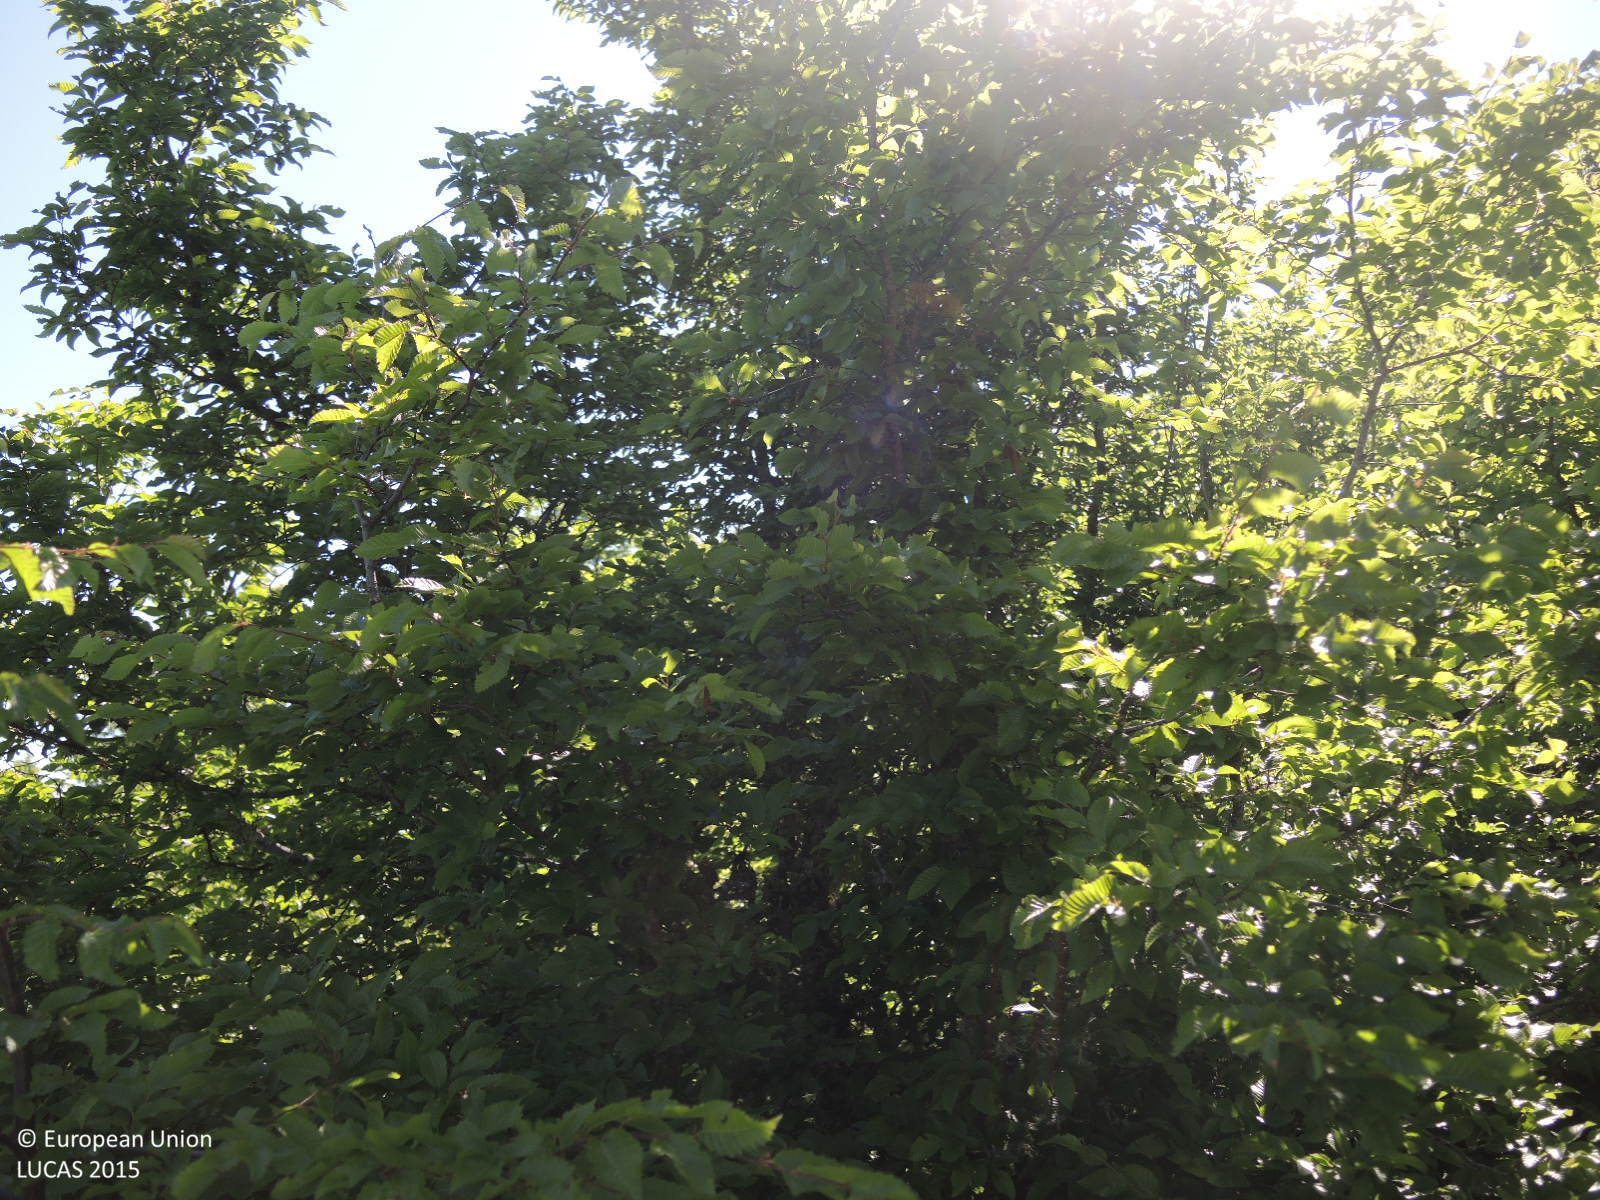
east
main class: Woodland
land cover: Broadleaved woodland
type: mesophytic deciduous forest
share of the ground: > 75 %
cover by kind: broadleaved forest trees 75 %, shrubs 10 %, consolidated bare surface 10 %, unconsolidated bare surface 5 %
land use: Semi-natural and natural areas not in use
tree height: < 5 m
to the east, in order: Broadleaved woodland; Dry stone walls; Broadleaved woodland; Dry stone walls; Broadleaved woodland; Dry stone walls; Shrubland with sparse tree cover; Dry stone walls; Tracks; Dry stone walls; Vineyards; Dry stone walls; Cherry fruit
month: June
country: HR
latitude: 43.6225
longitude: 16.1996
